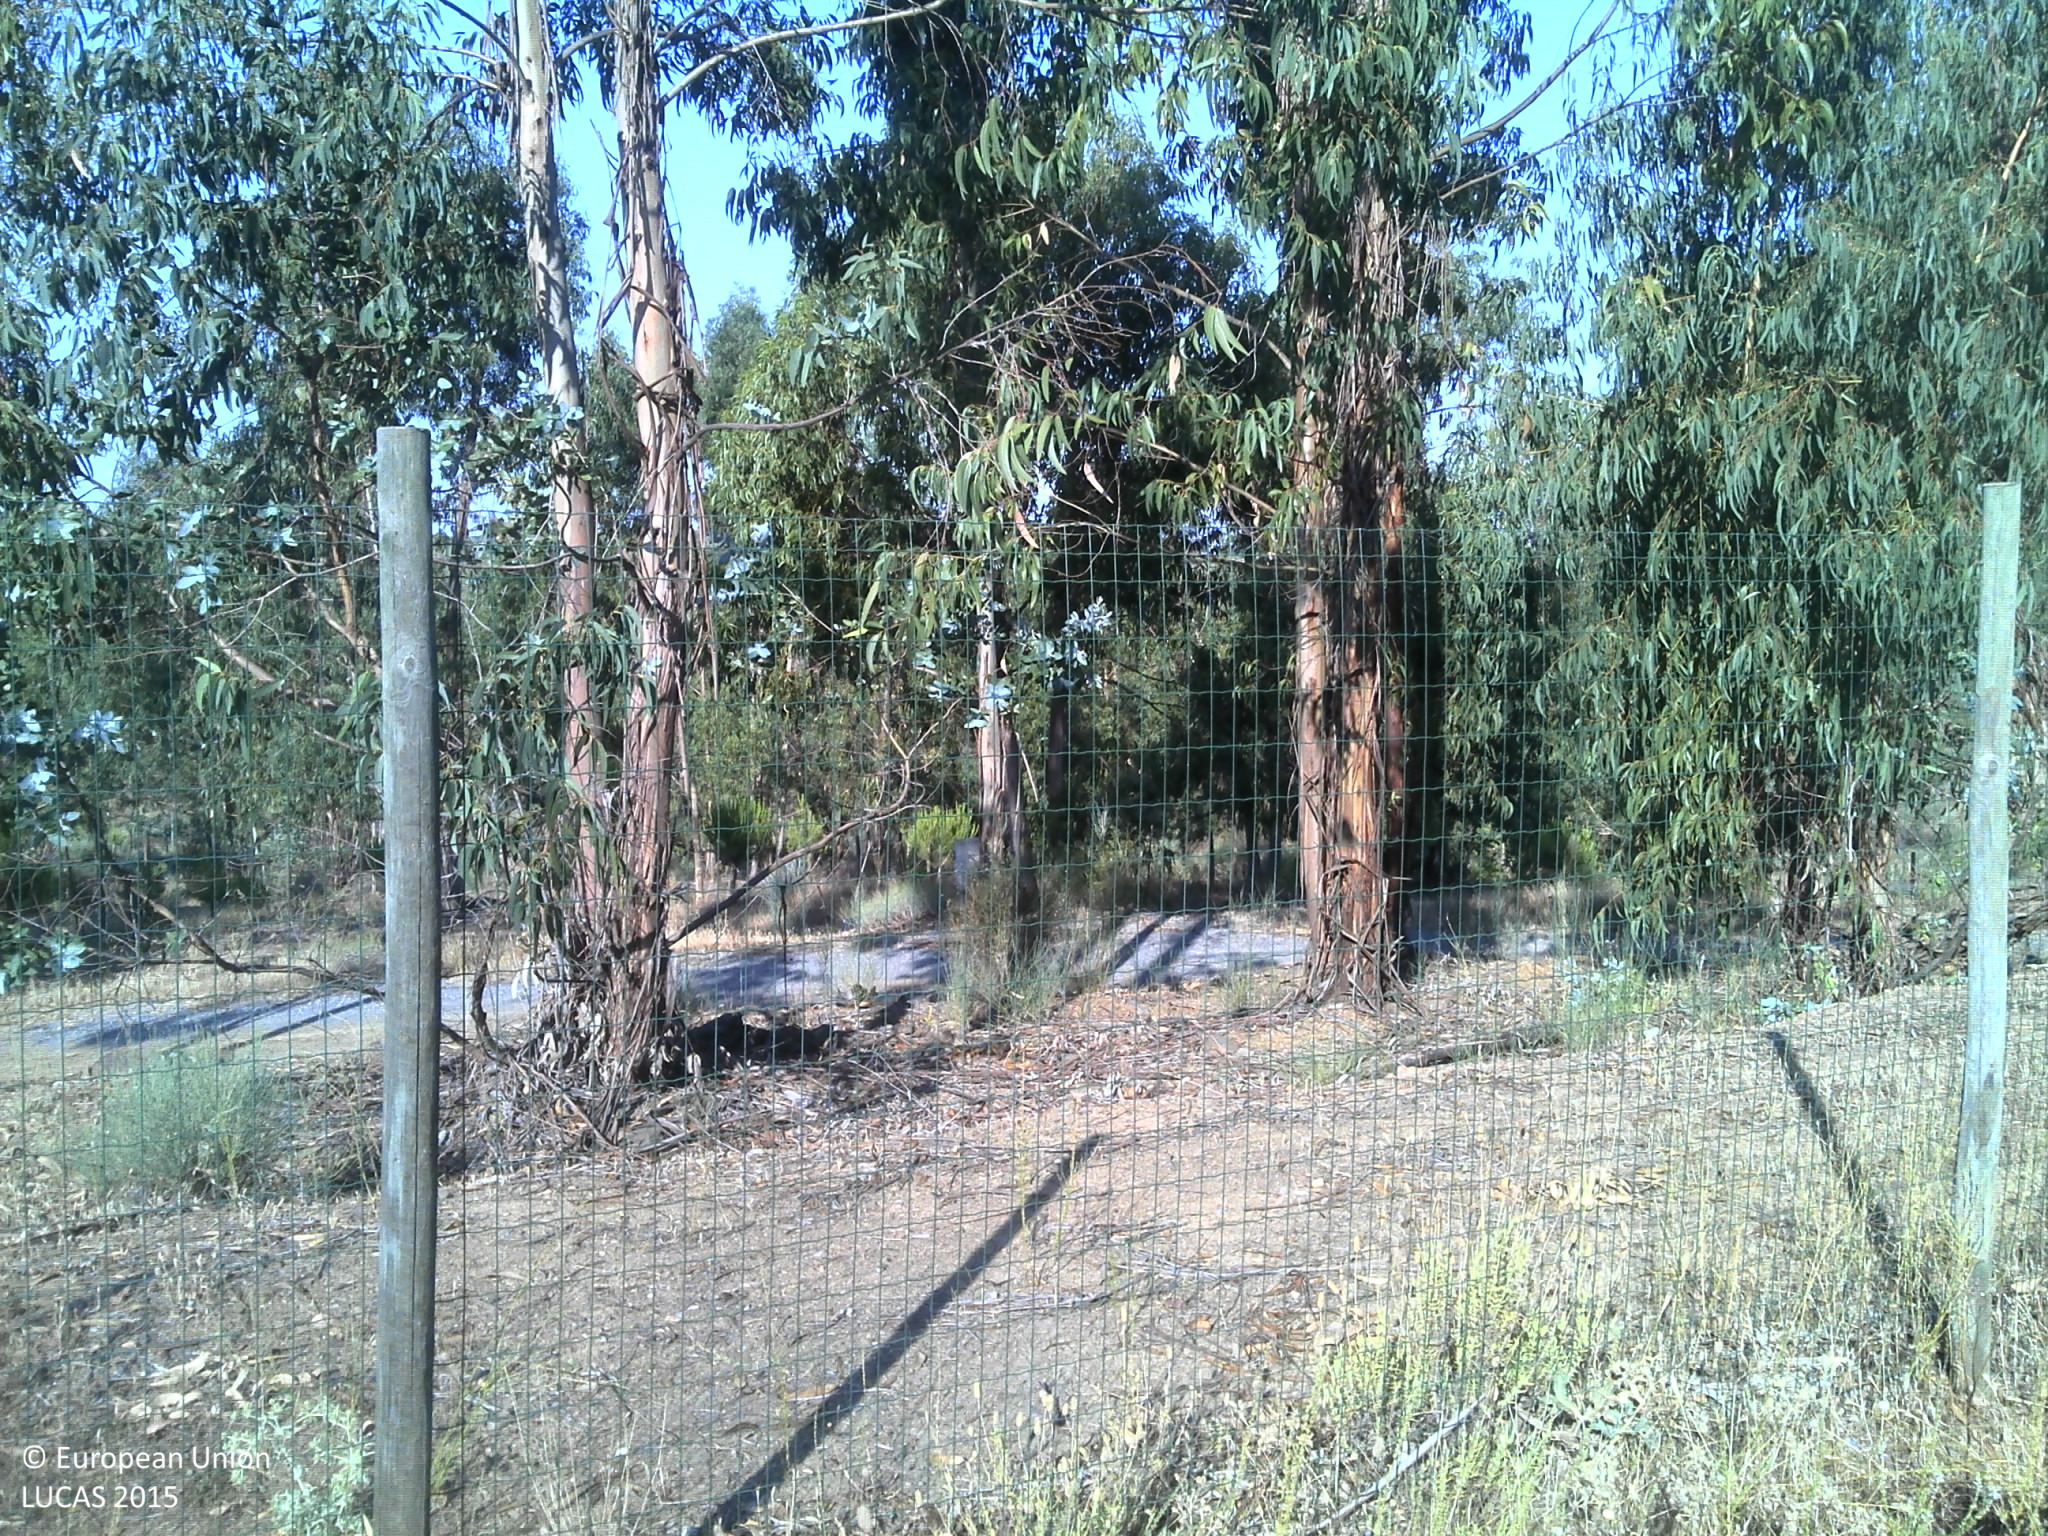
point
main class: Woodland
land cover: Broadleaved woodland
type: broadleaved evergreen forest
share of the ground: 50 - 75 %
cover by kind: broadleaved forest trees 50 %, herbaceous plants 40 %, unconsolidated bare surface 10 %
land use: Forestry
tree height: > 5 m
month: June
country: PT
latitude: 39.9185
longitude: -7.1862
